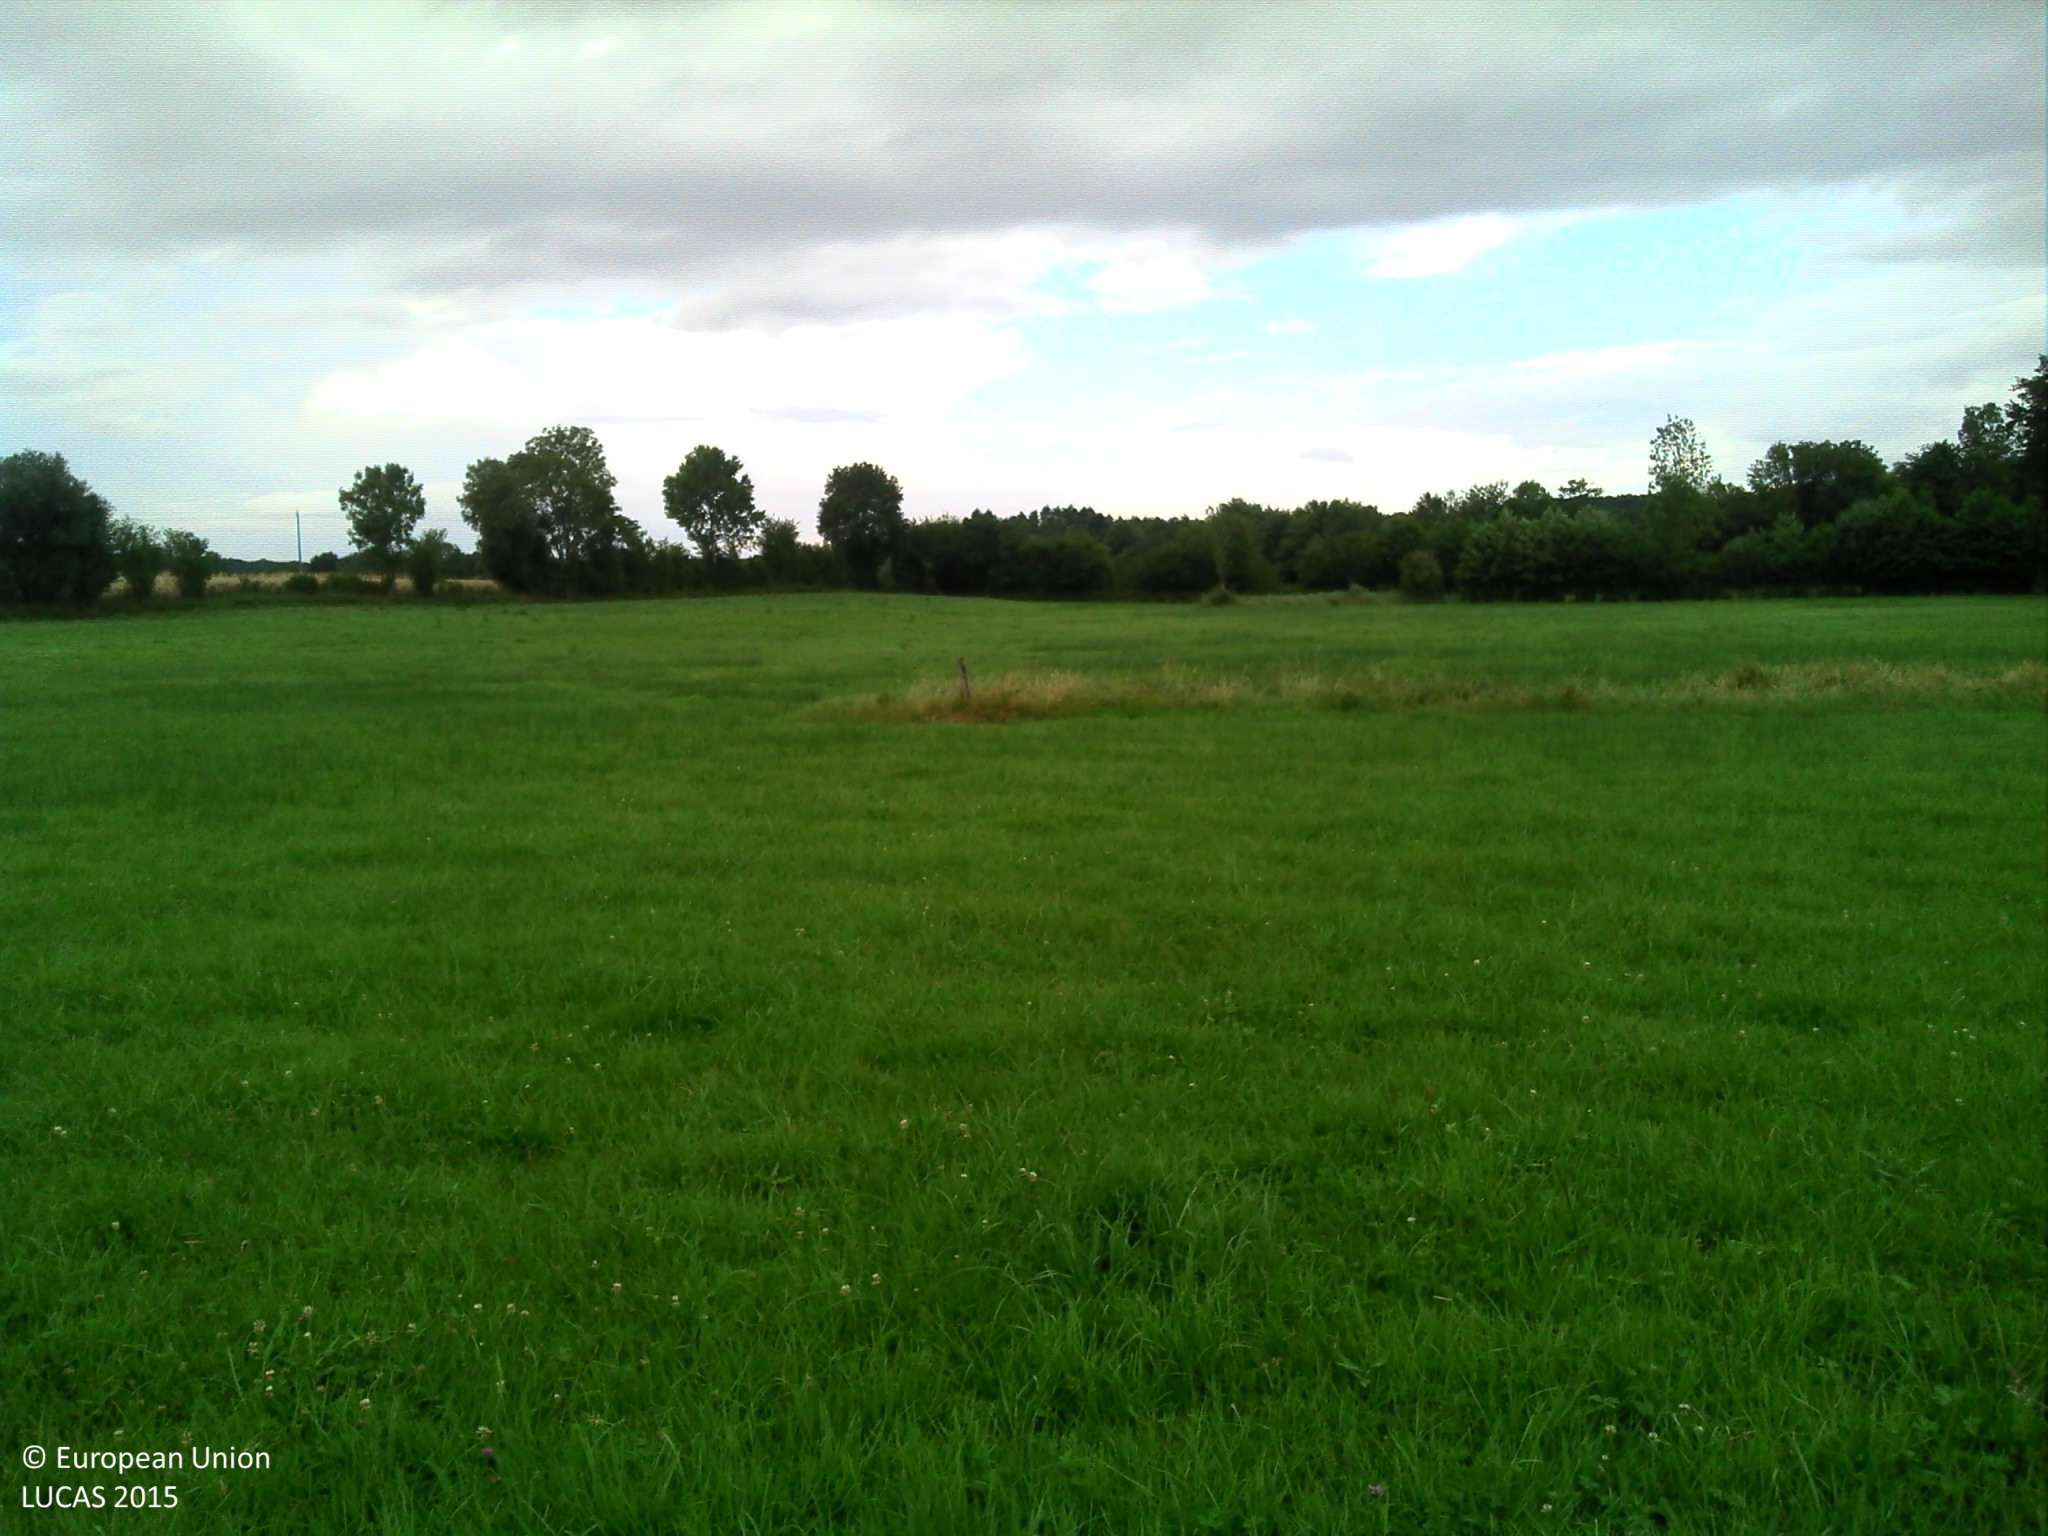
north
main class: Grassland
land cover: Grassland without tree/shrub cover
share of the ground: > 75 %
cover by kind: herbaceous plants 100 %
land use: Agriculture (excluding fallow land and kitchen gardens)
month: July
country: FR
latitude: 48.5711
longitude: 0.4743
